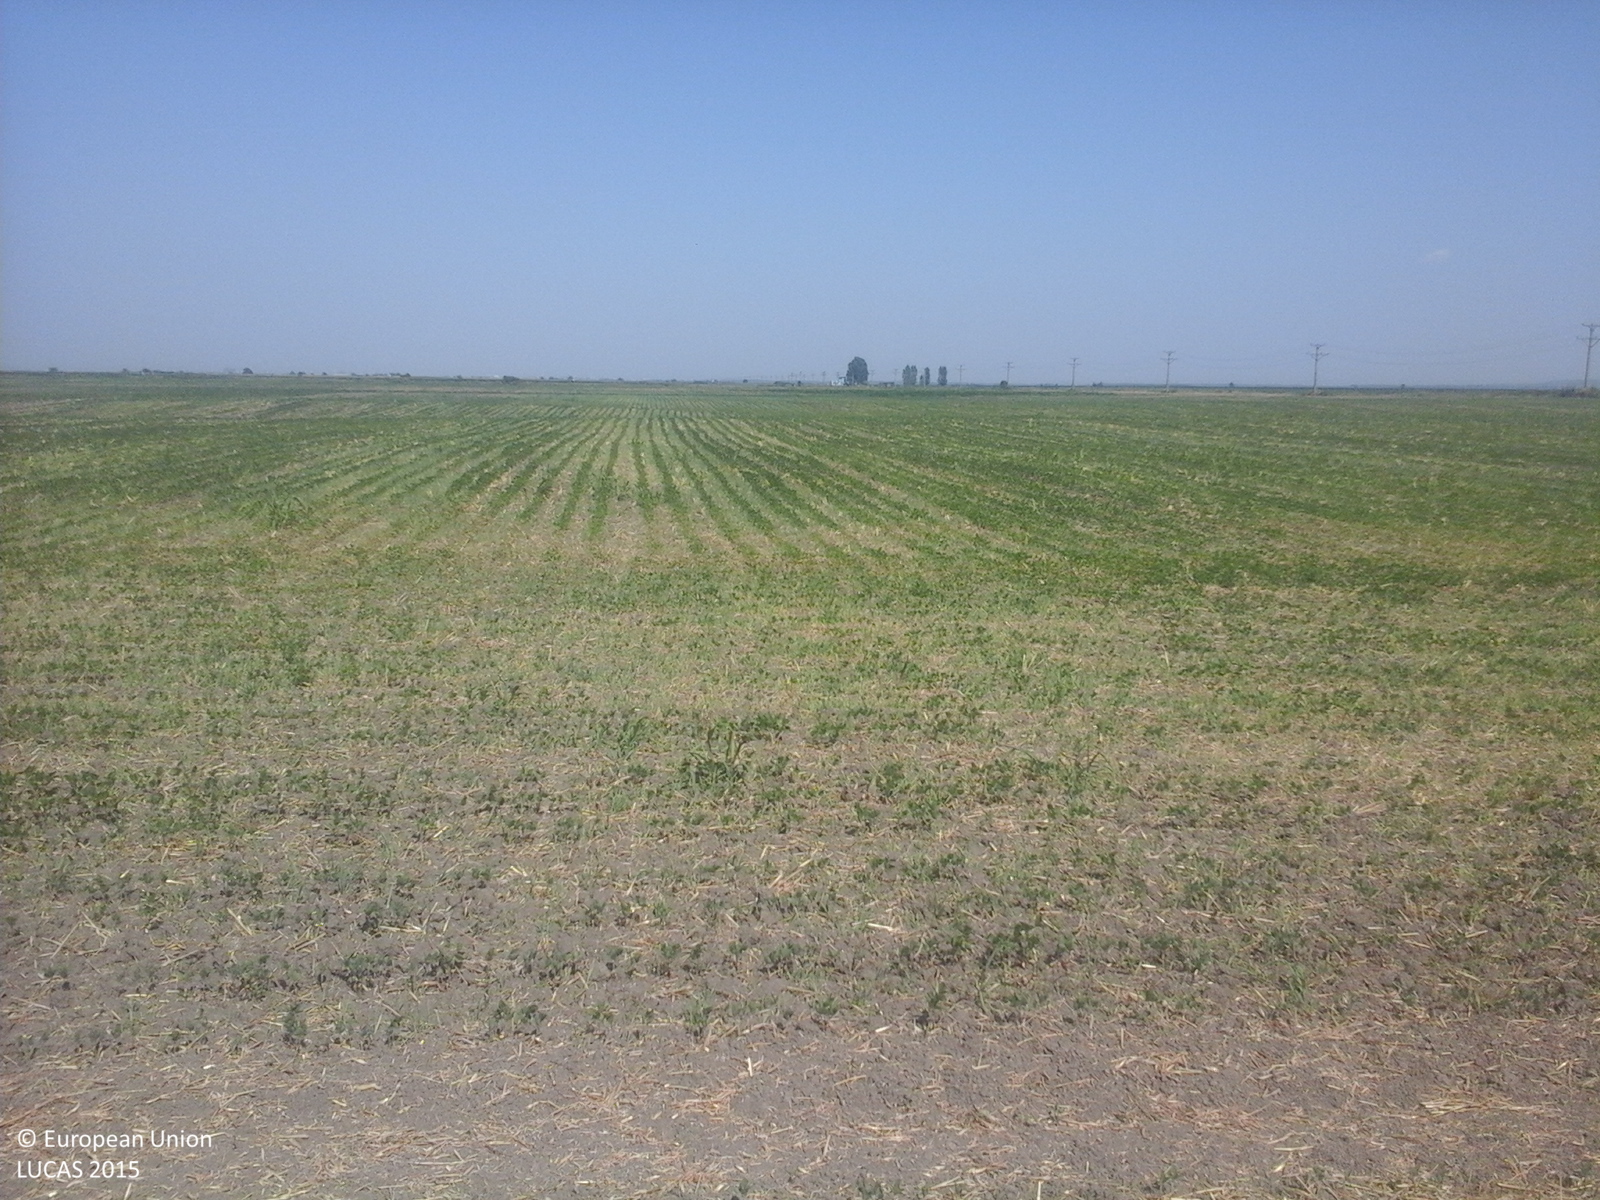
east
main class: Cropland
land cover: Soya
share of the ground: < 10 %
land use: Agriculture (excluding fallow land and kitchen gardens)
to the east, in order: Soya
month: July
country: RO
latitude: 44.1833
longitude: 27.1292
